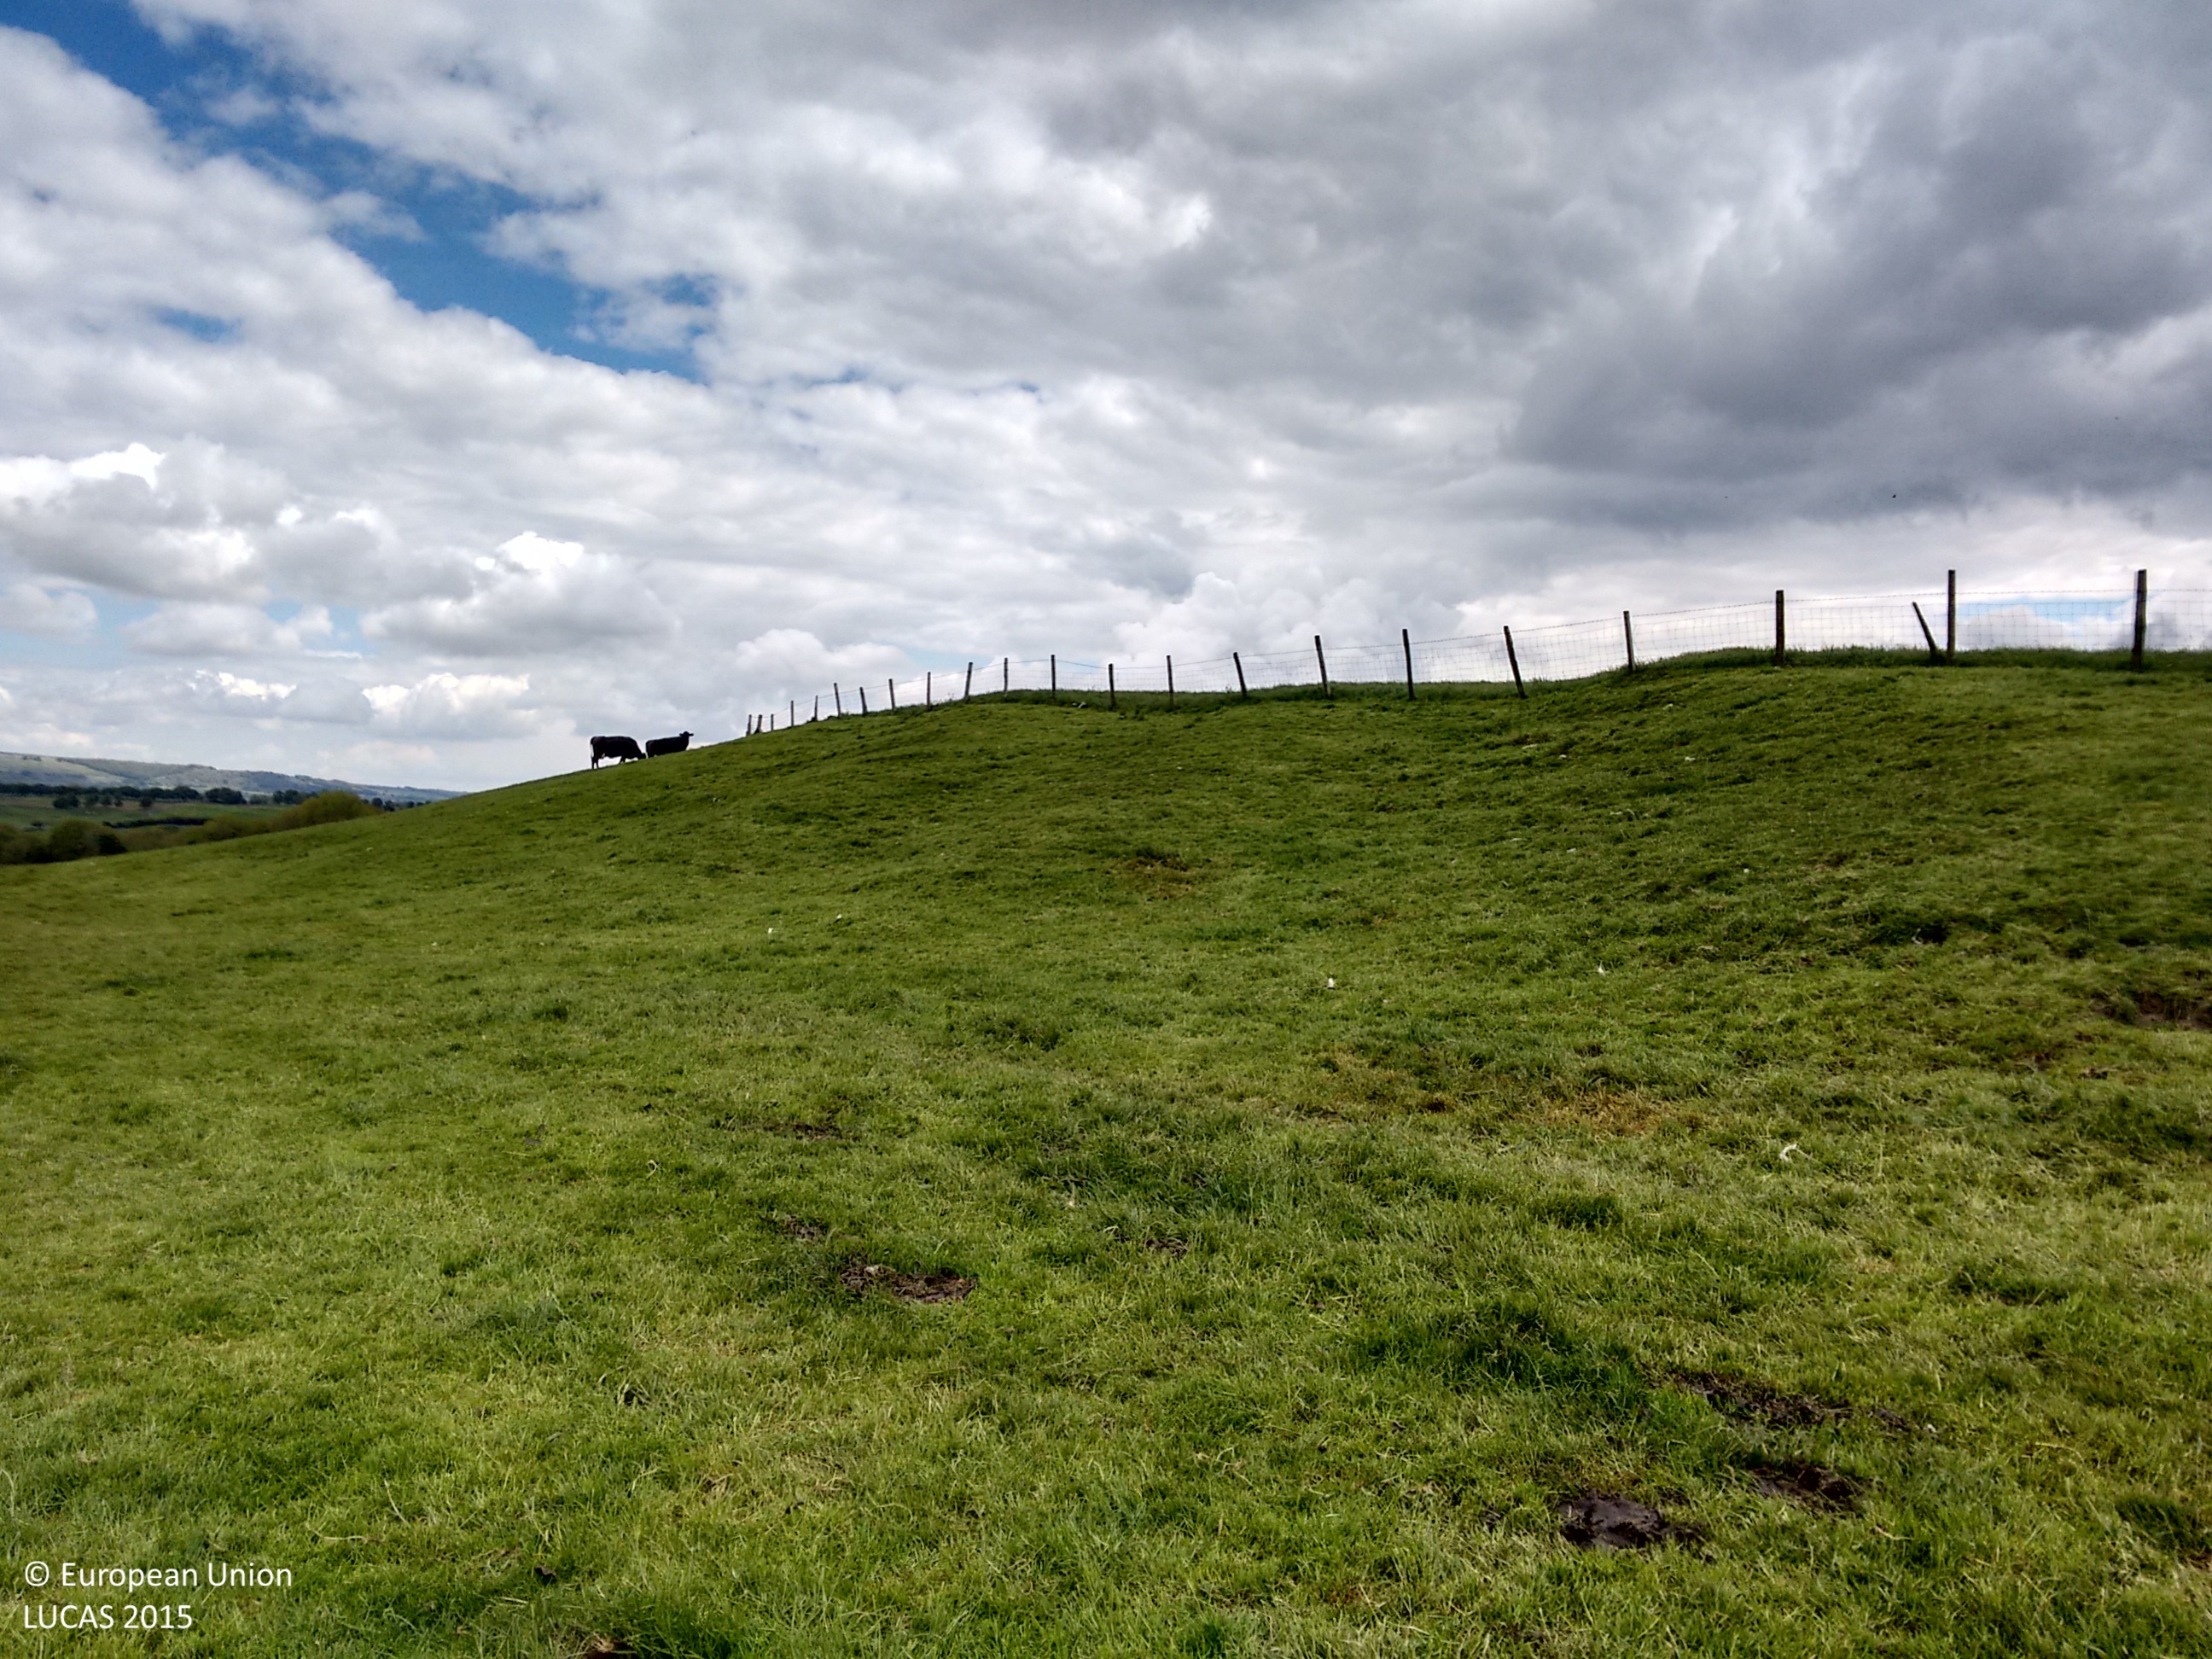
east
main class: Grassland
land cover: Grassland without tree/shrub cover
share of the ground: > 75 %
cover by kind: herbaceous plants 100 %
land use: Agriculture (excluding fallow land and kitchen gardens)
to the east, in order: Grassland without tree/shrub cover; Fences; Grassland without tree/shrub cover
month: June
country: GB
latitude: 54.2916
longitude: -2.0246
